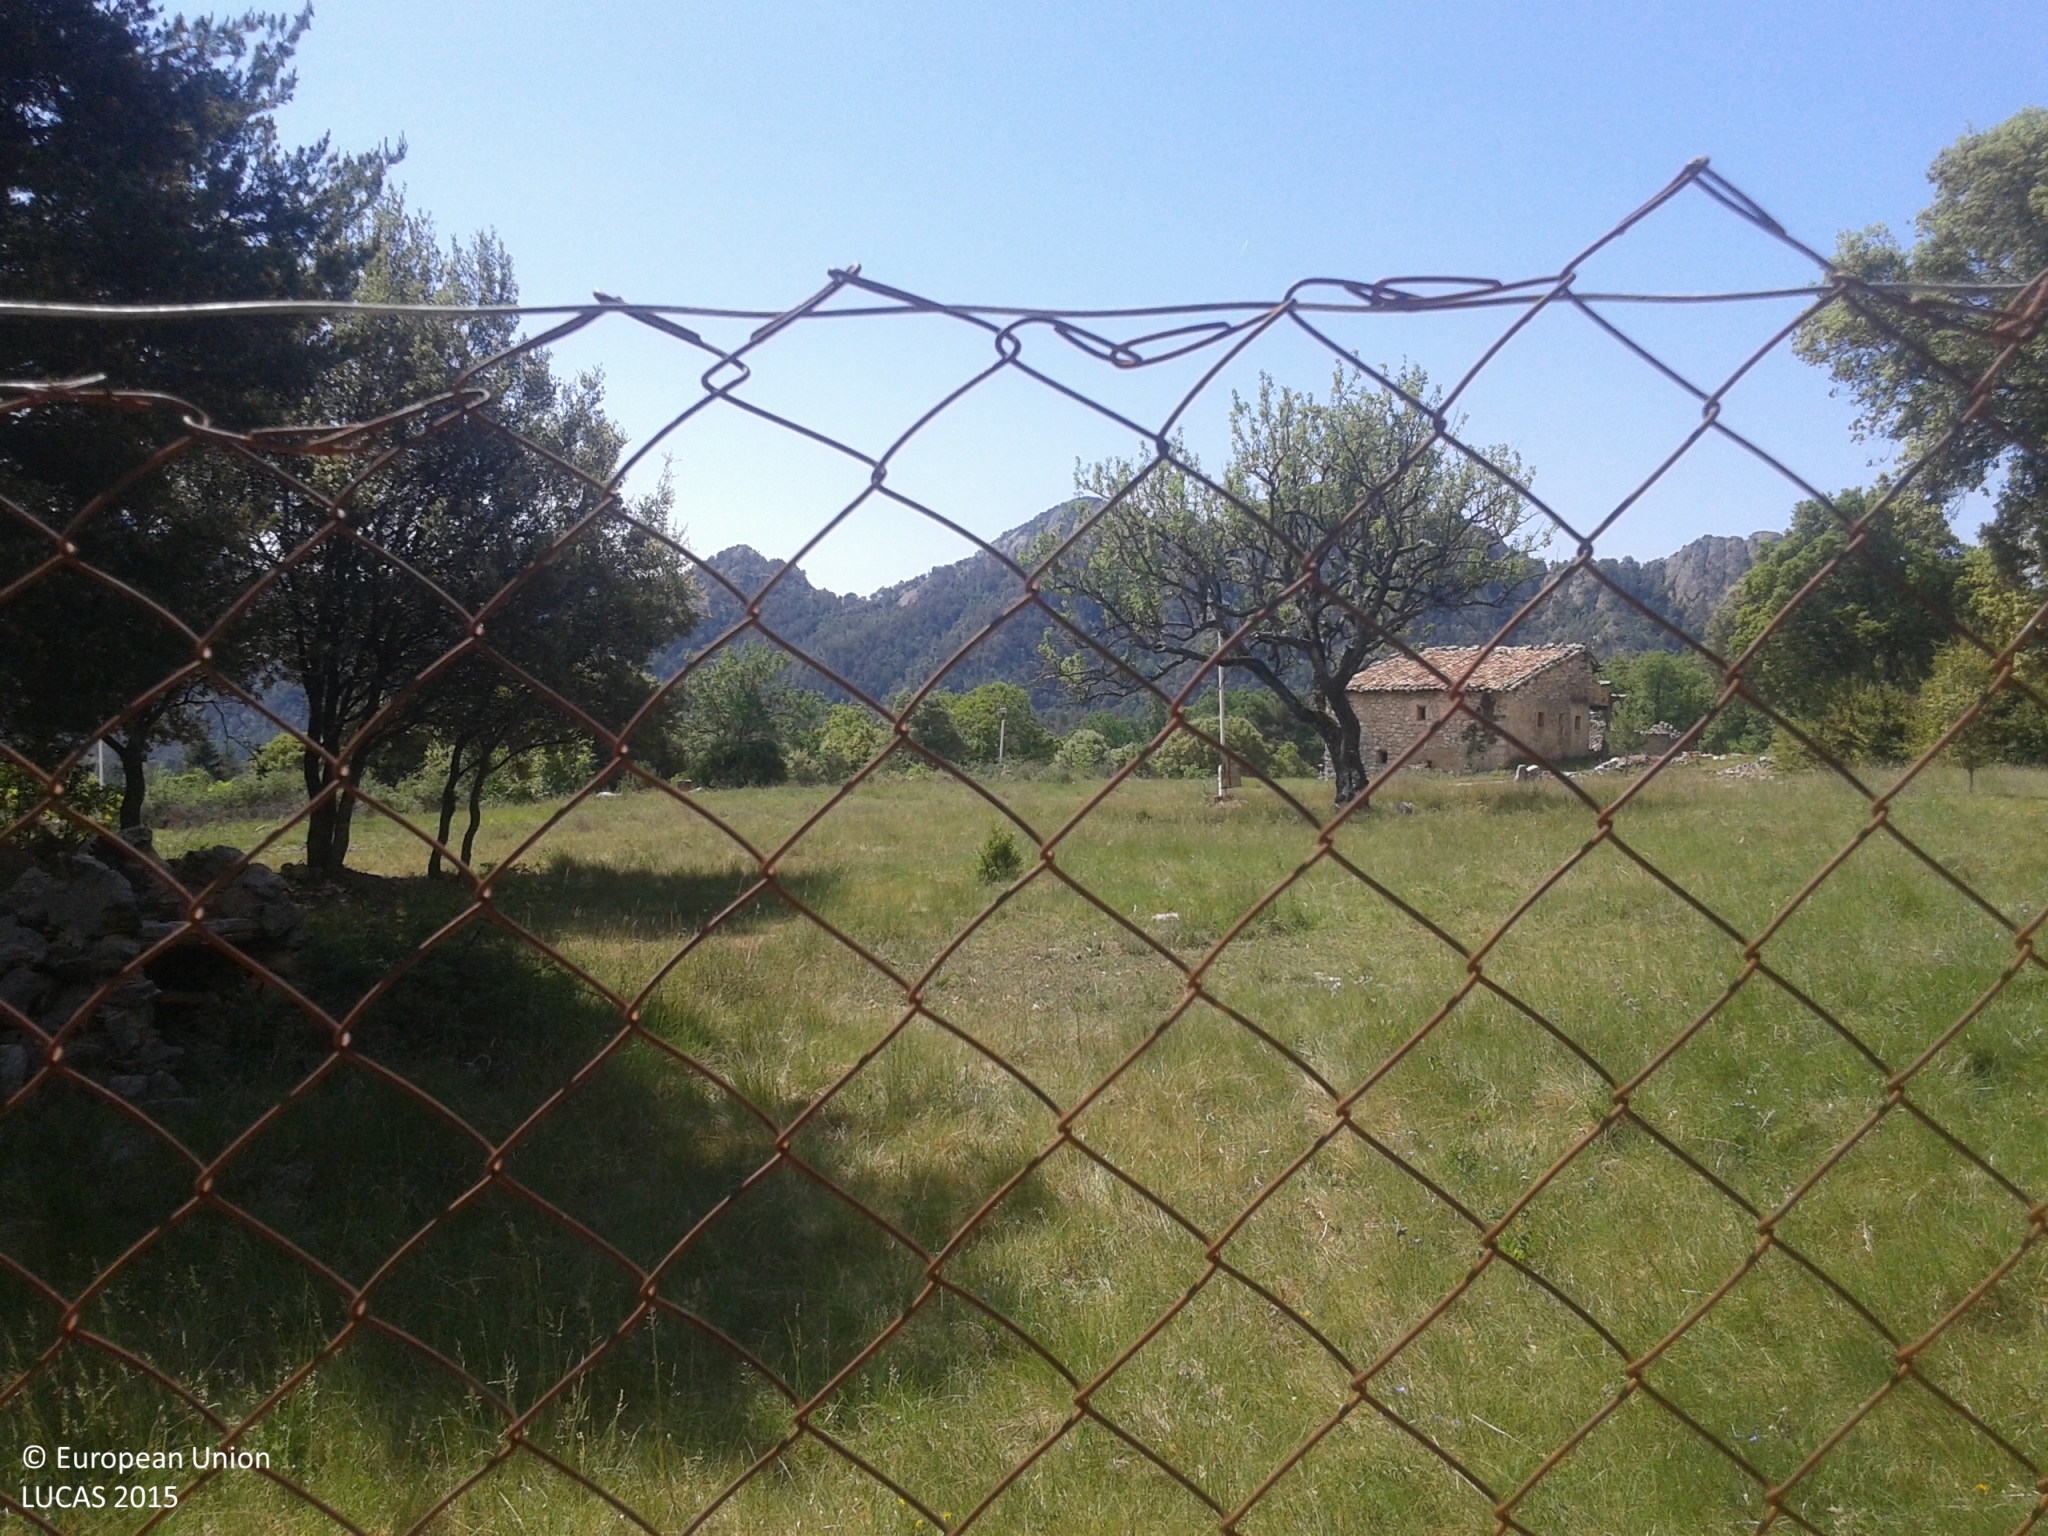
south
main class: Grassland
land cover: Grassland with sparse tree/shrub cover
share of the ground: > 75 %
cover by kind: herbaceous plants 95 %, broadleaved forest trees 5 %
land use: Agriculture (excluding fallow land and kitchen gardens)
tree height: > 5 m
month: May
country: ES
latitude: 42.1395
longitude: 1.5786
